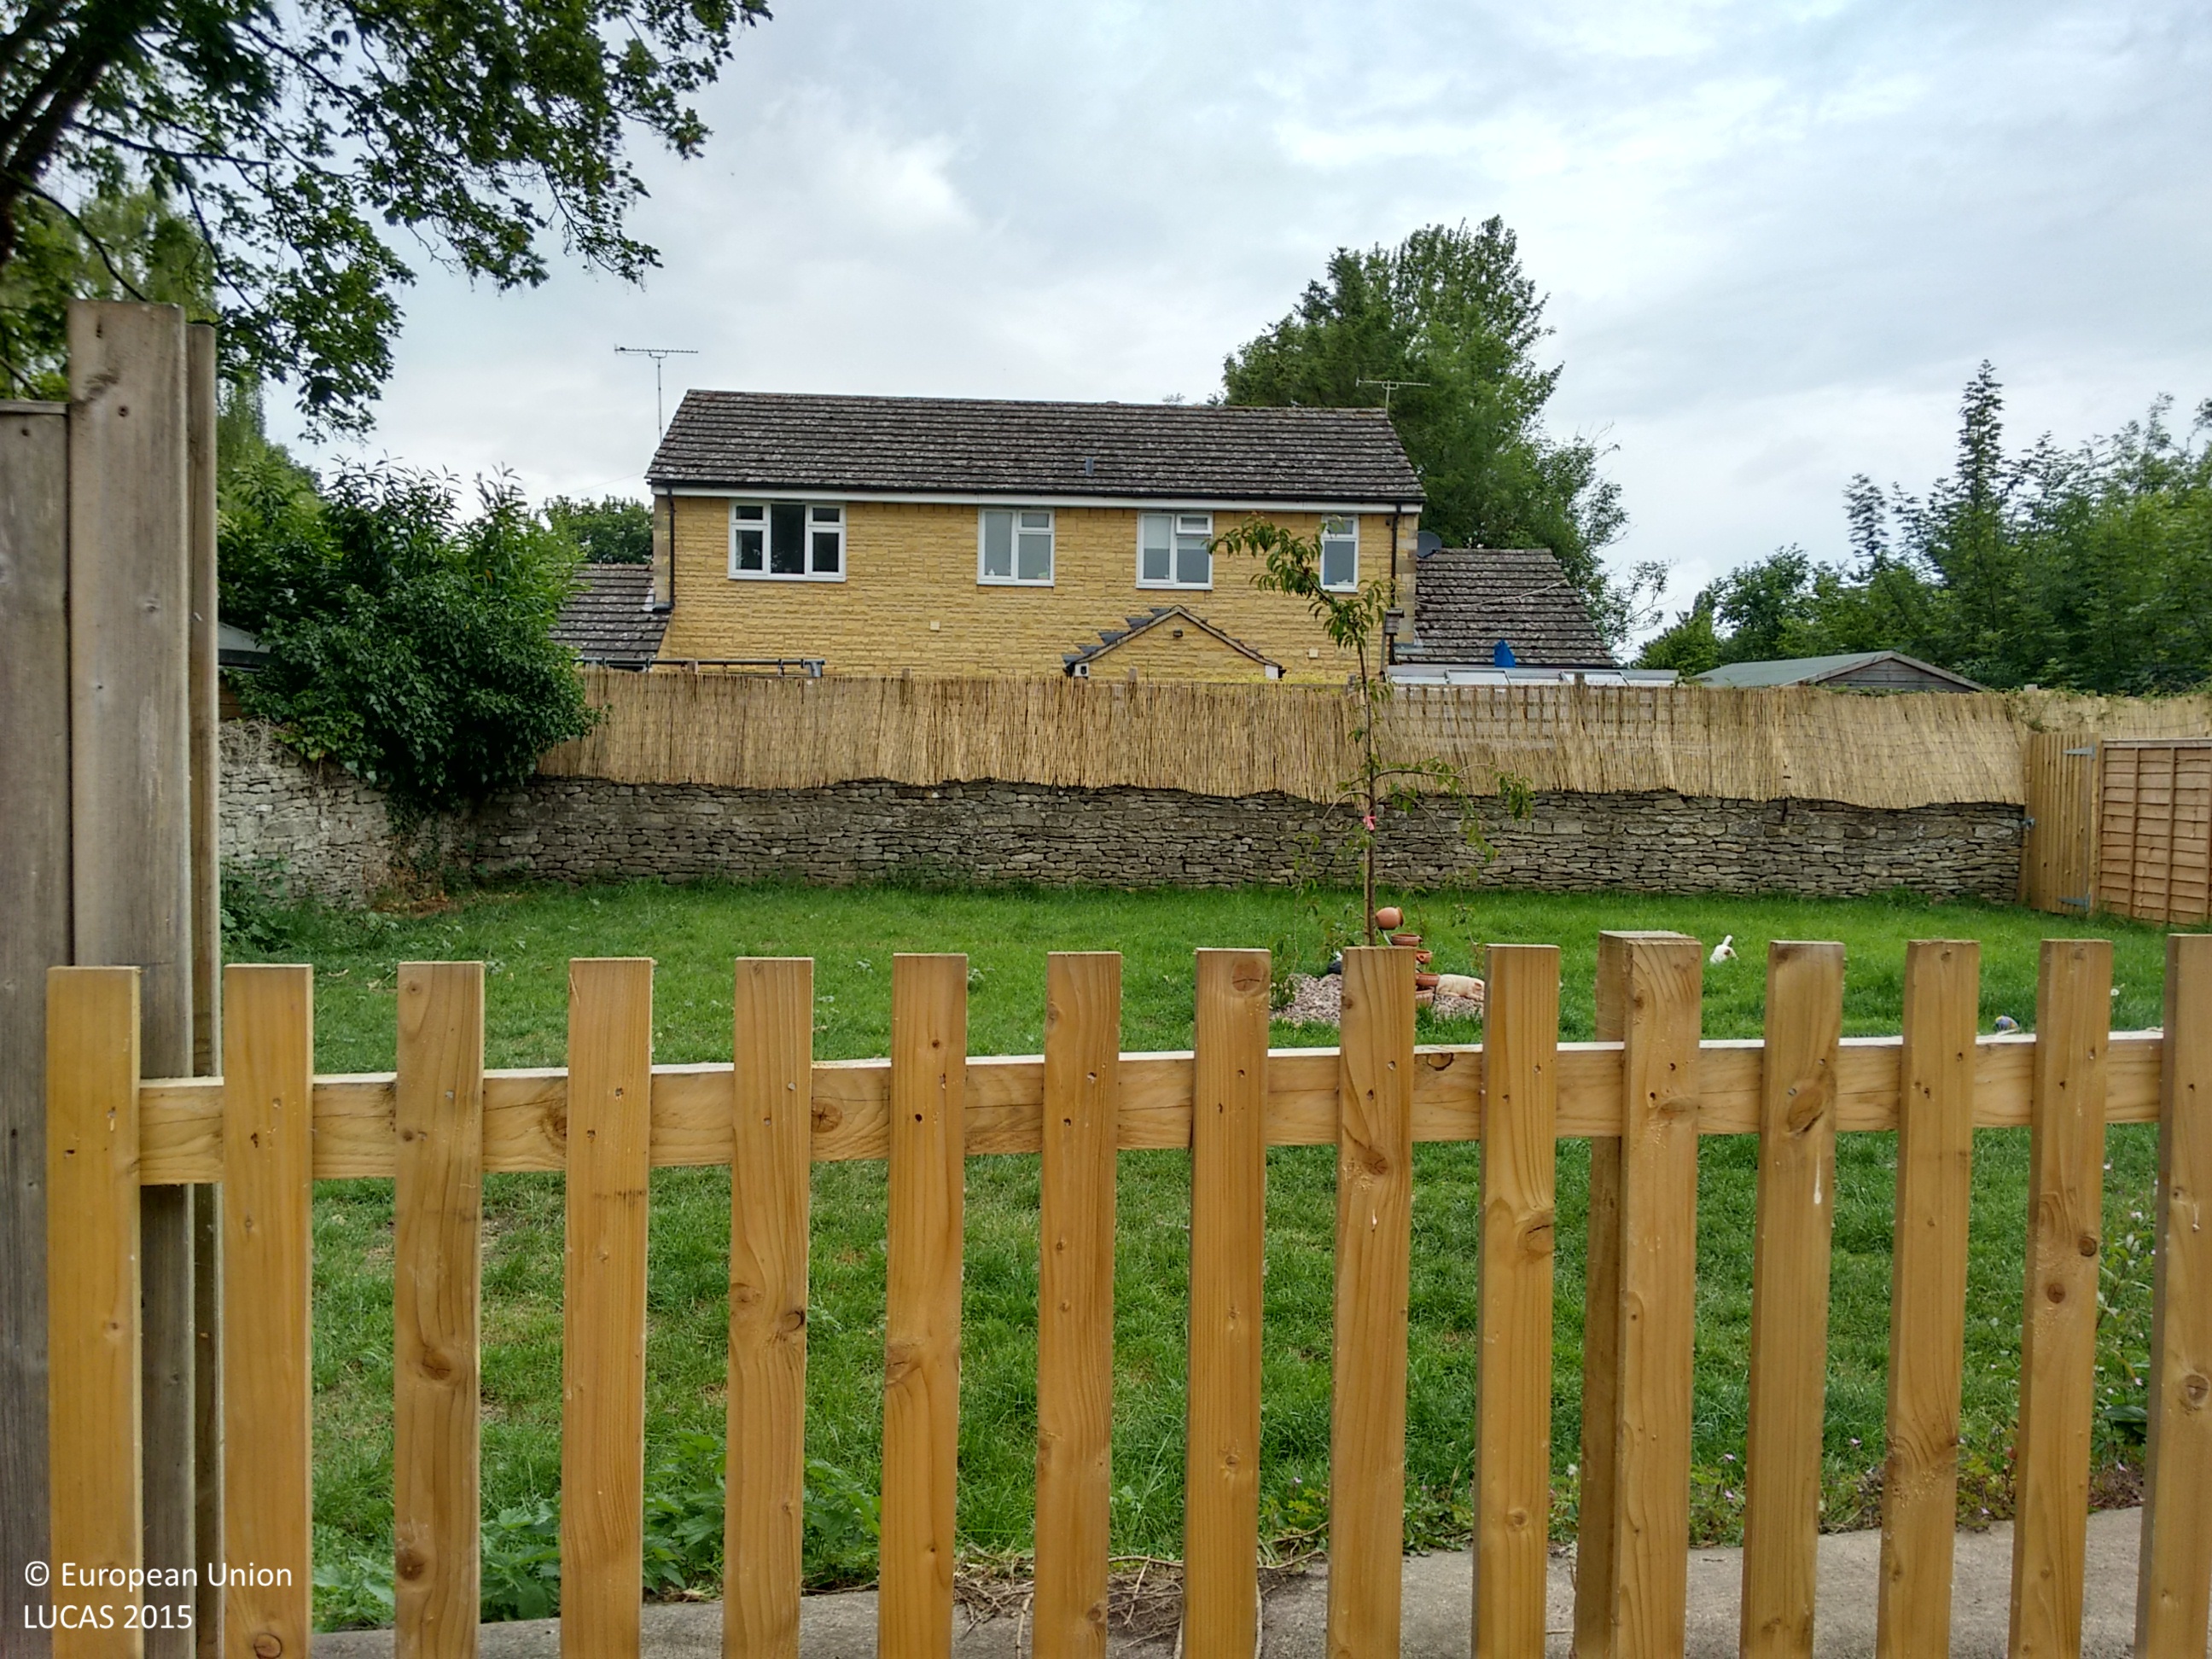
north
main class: Woodland
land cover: Broadleaved woodland
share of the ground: 50 - 75 %
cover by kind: broadleaved forest trees 60 %, herbaceous plants 20 %
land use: Residential
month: June
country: GB
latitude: 51.7168
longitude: -1.5886
